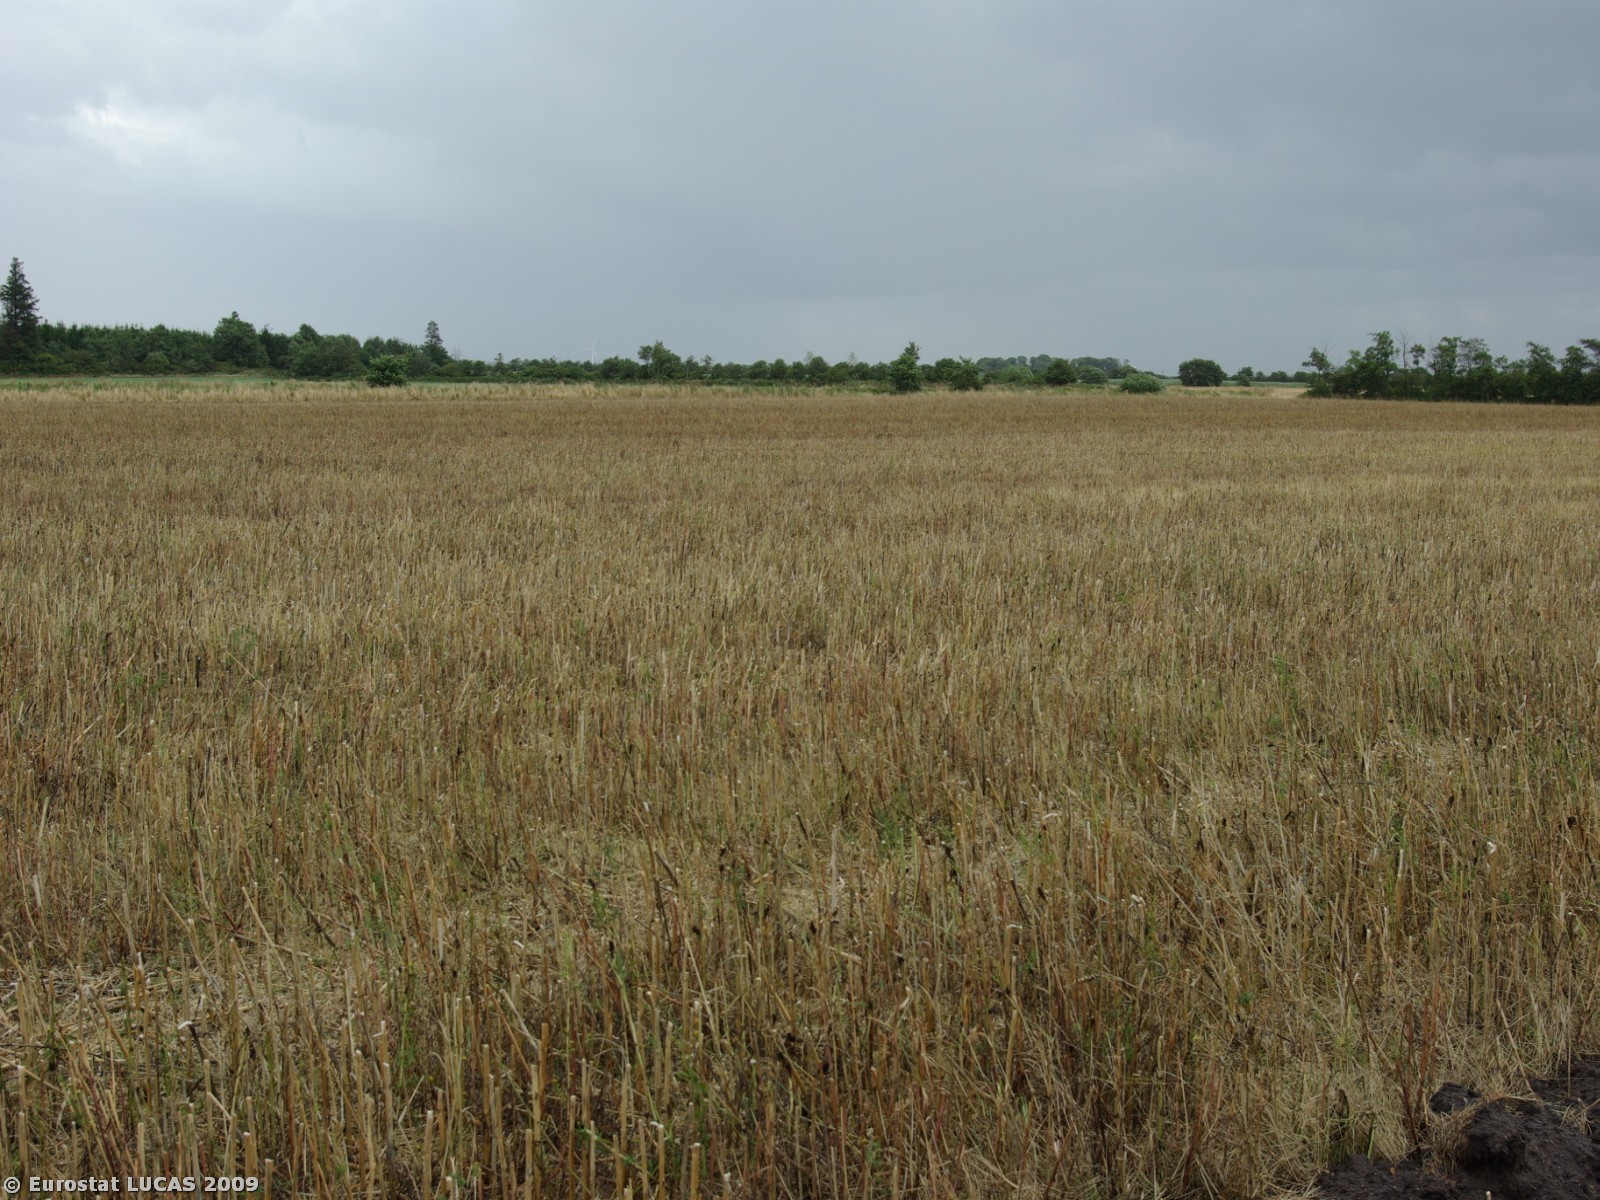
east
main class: Cropland
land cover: Rape and turnip rape
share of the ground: < 10 %
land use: Agriculture (excluding fallow land and kitchen gardens)
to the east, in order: Rape and turnip rape
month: July
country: DK
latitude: 55.2312
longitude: 9.0103
